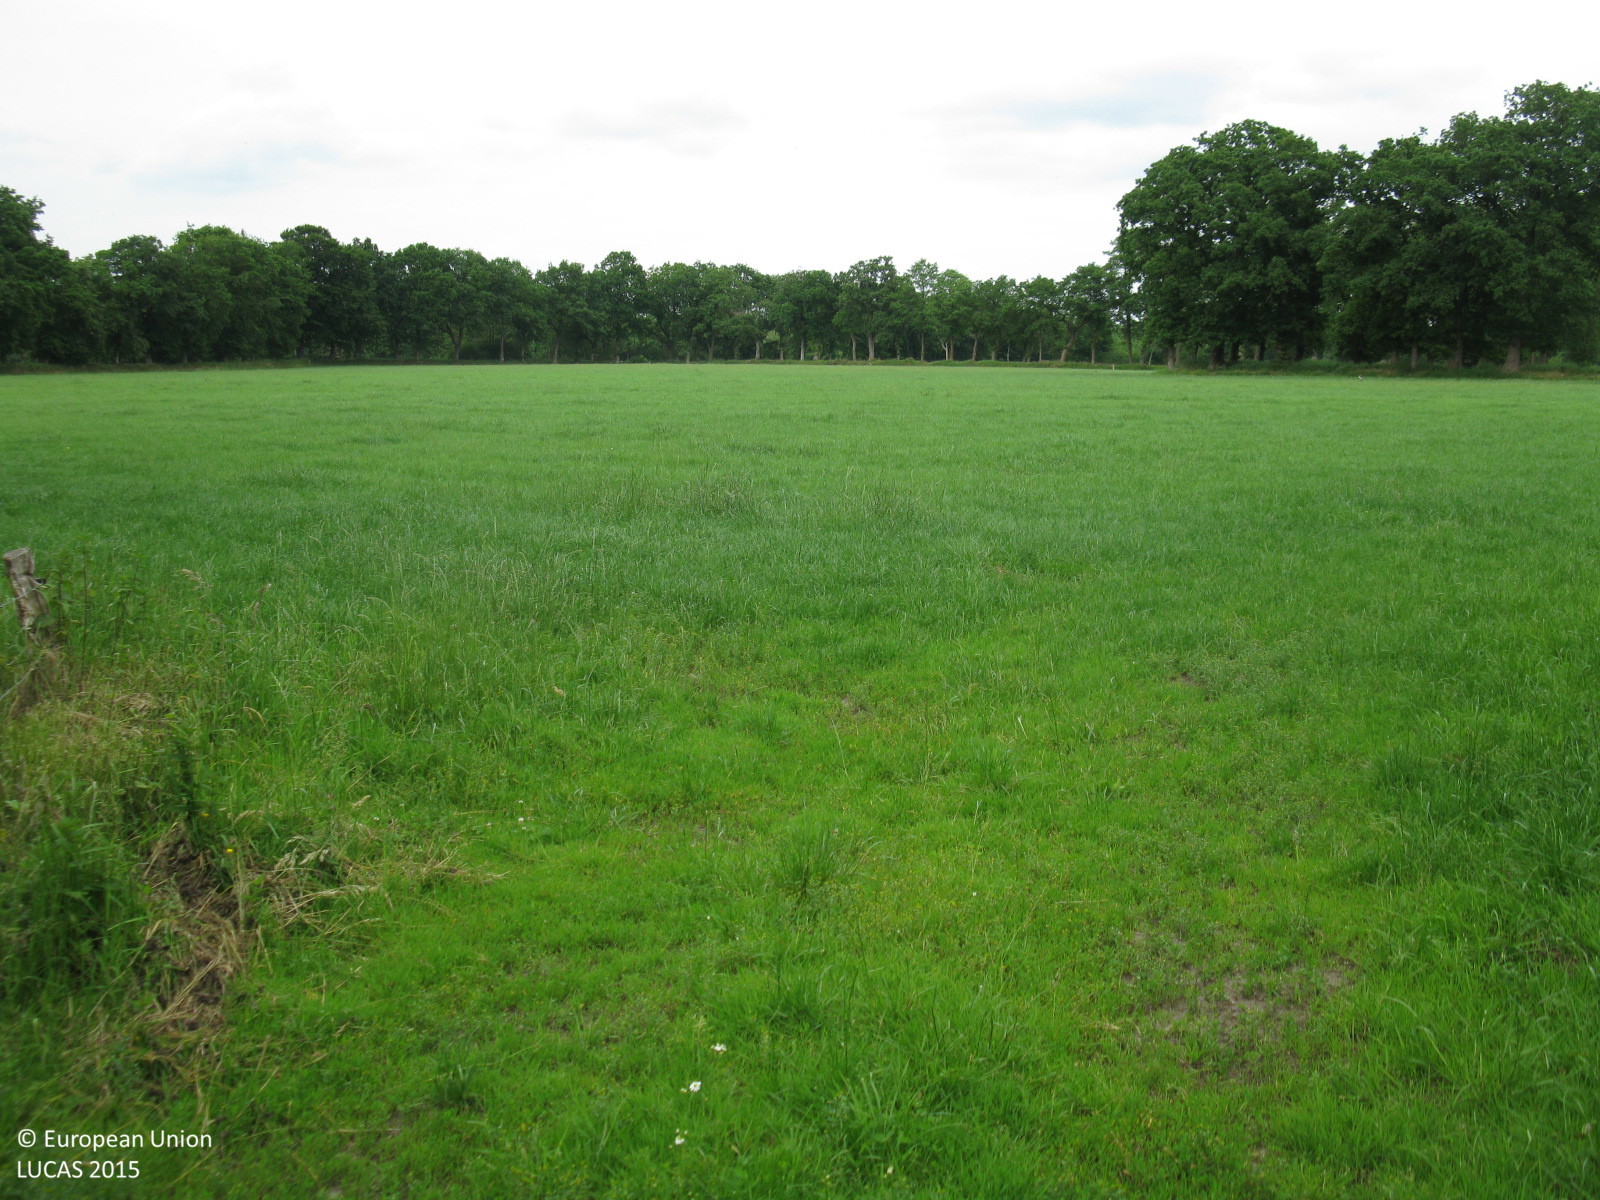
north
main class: Grassland
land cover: Grassland without tree/shrub cover
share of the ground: > 75 %
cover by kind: herbaceous plants 100 %
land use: Agriculture (excluding fallow land and kitchen gardens)
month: June
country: DE
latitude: 53.5091
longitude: 7.8746
